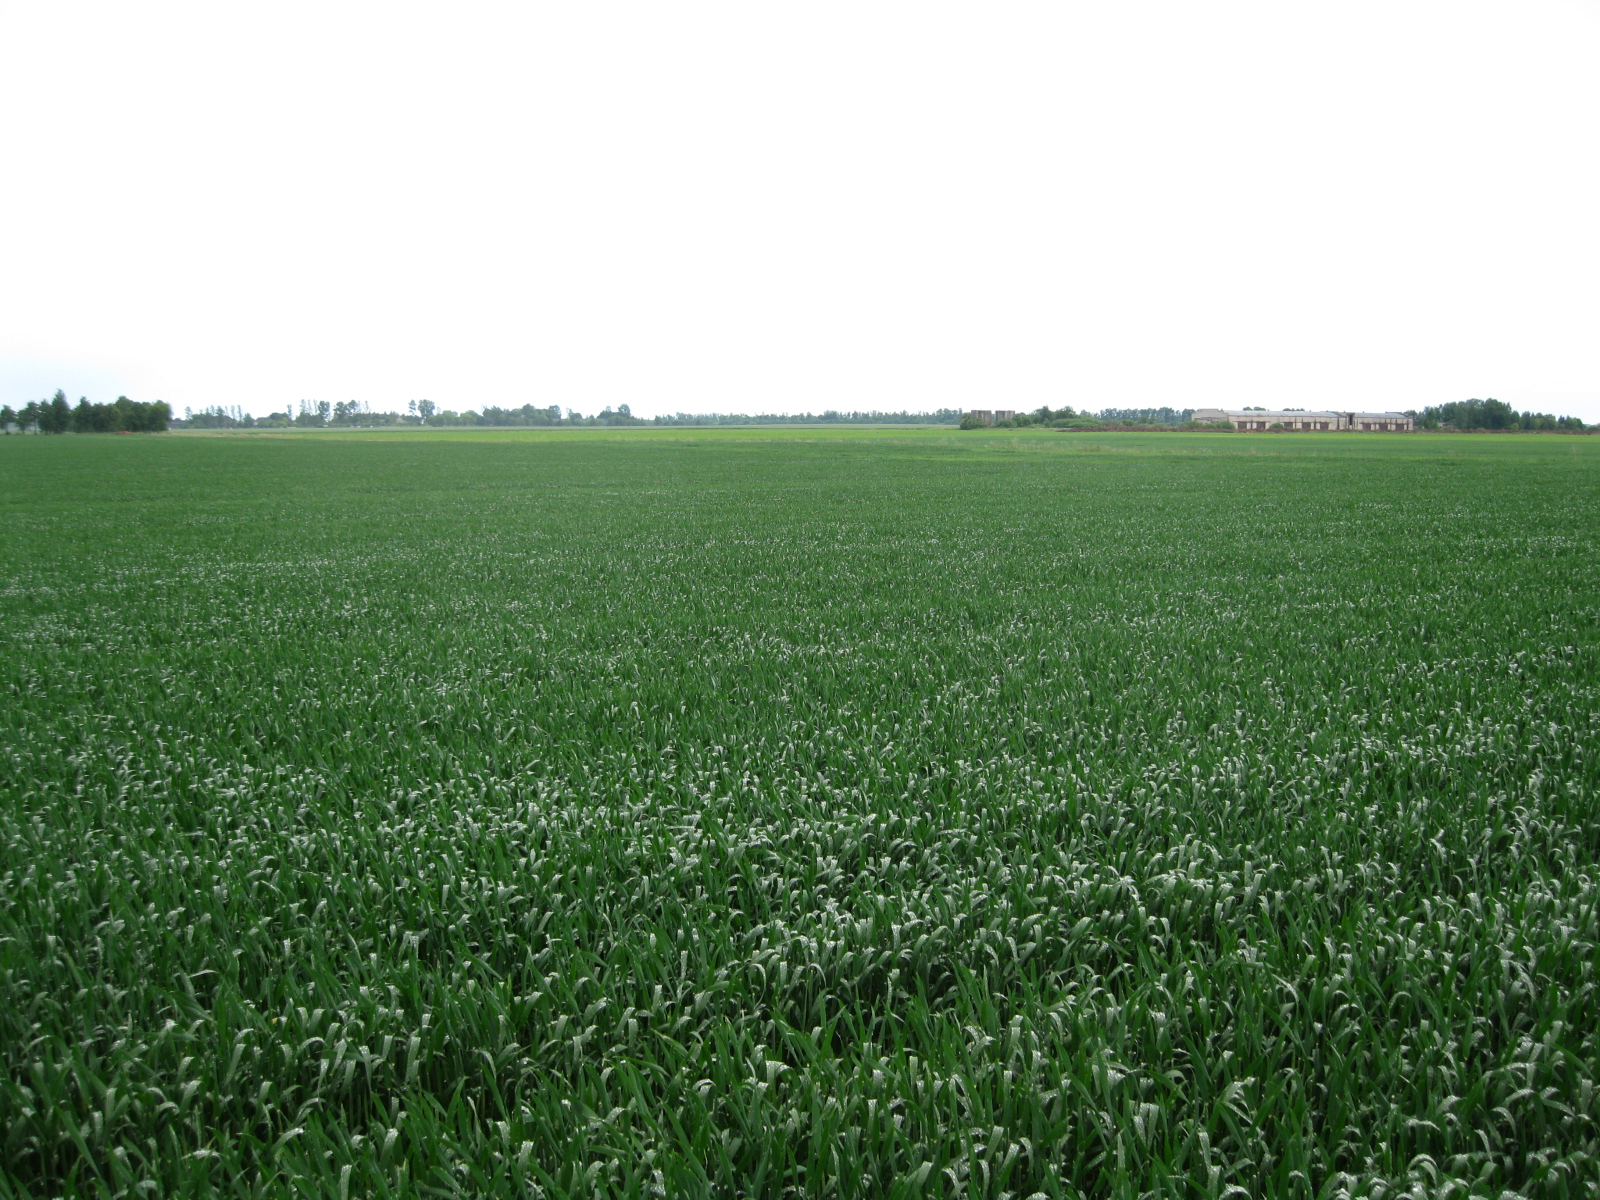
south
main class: Cropland
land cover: Common wheat
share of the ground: > 75 %
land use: Agriculture (excluding fallow land and kitchen gardens)
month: June
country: LT
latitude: 55.4492
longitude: 23.8572
